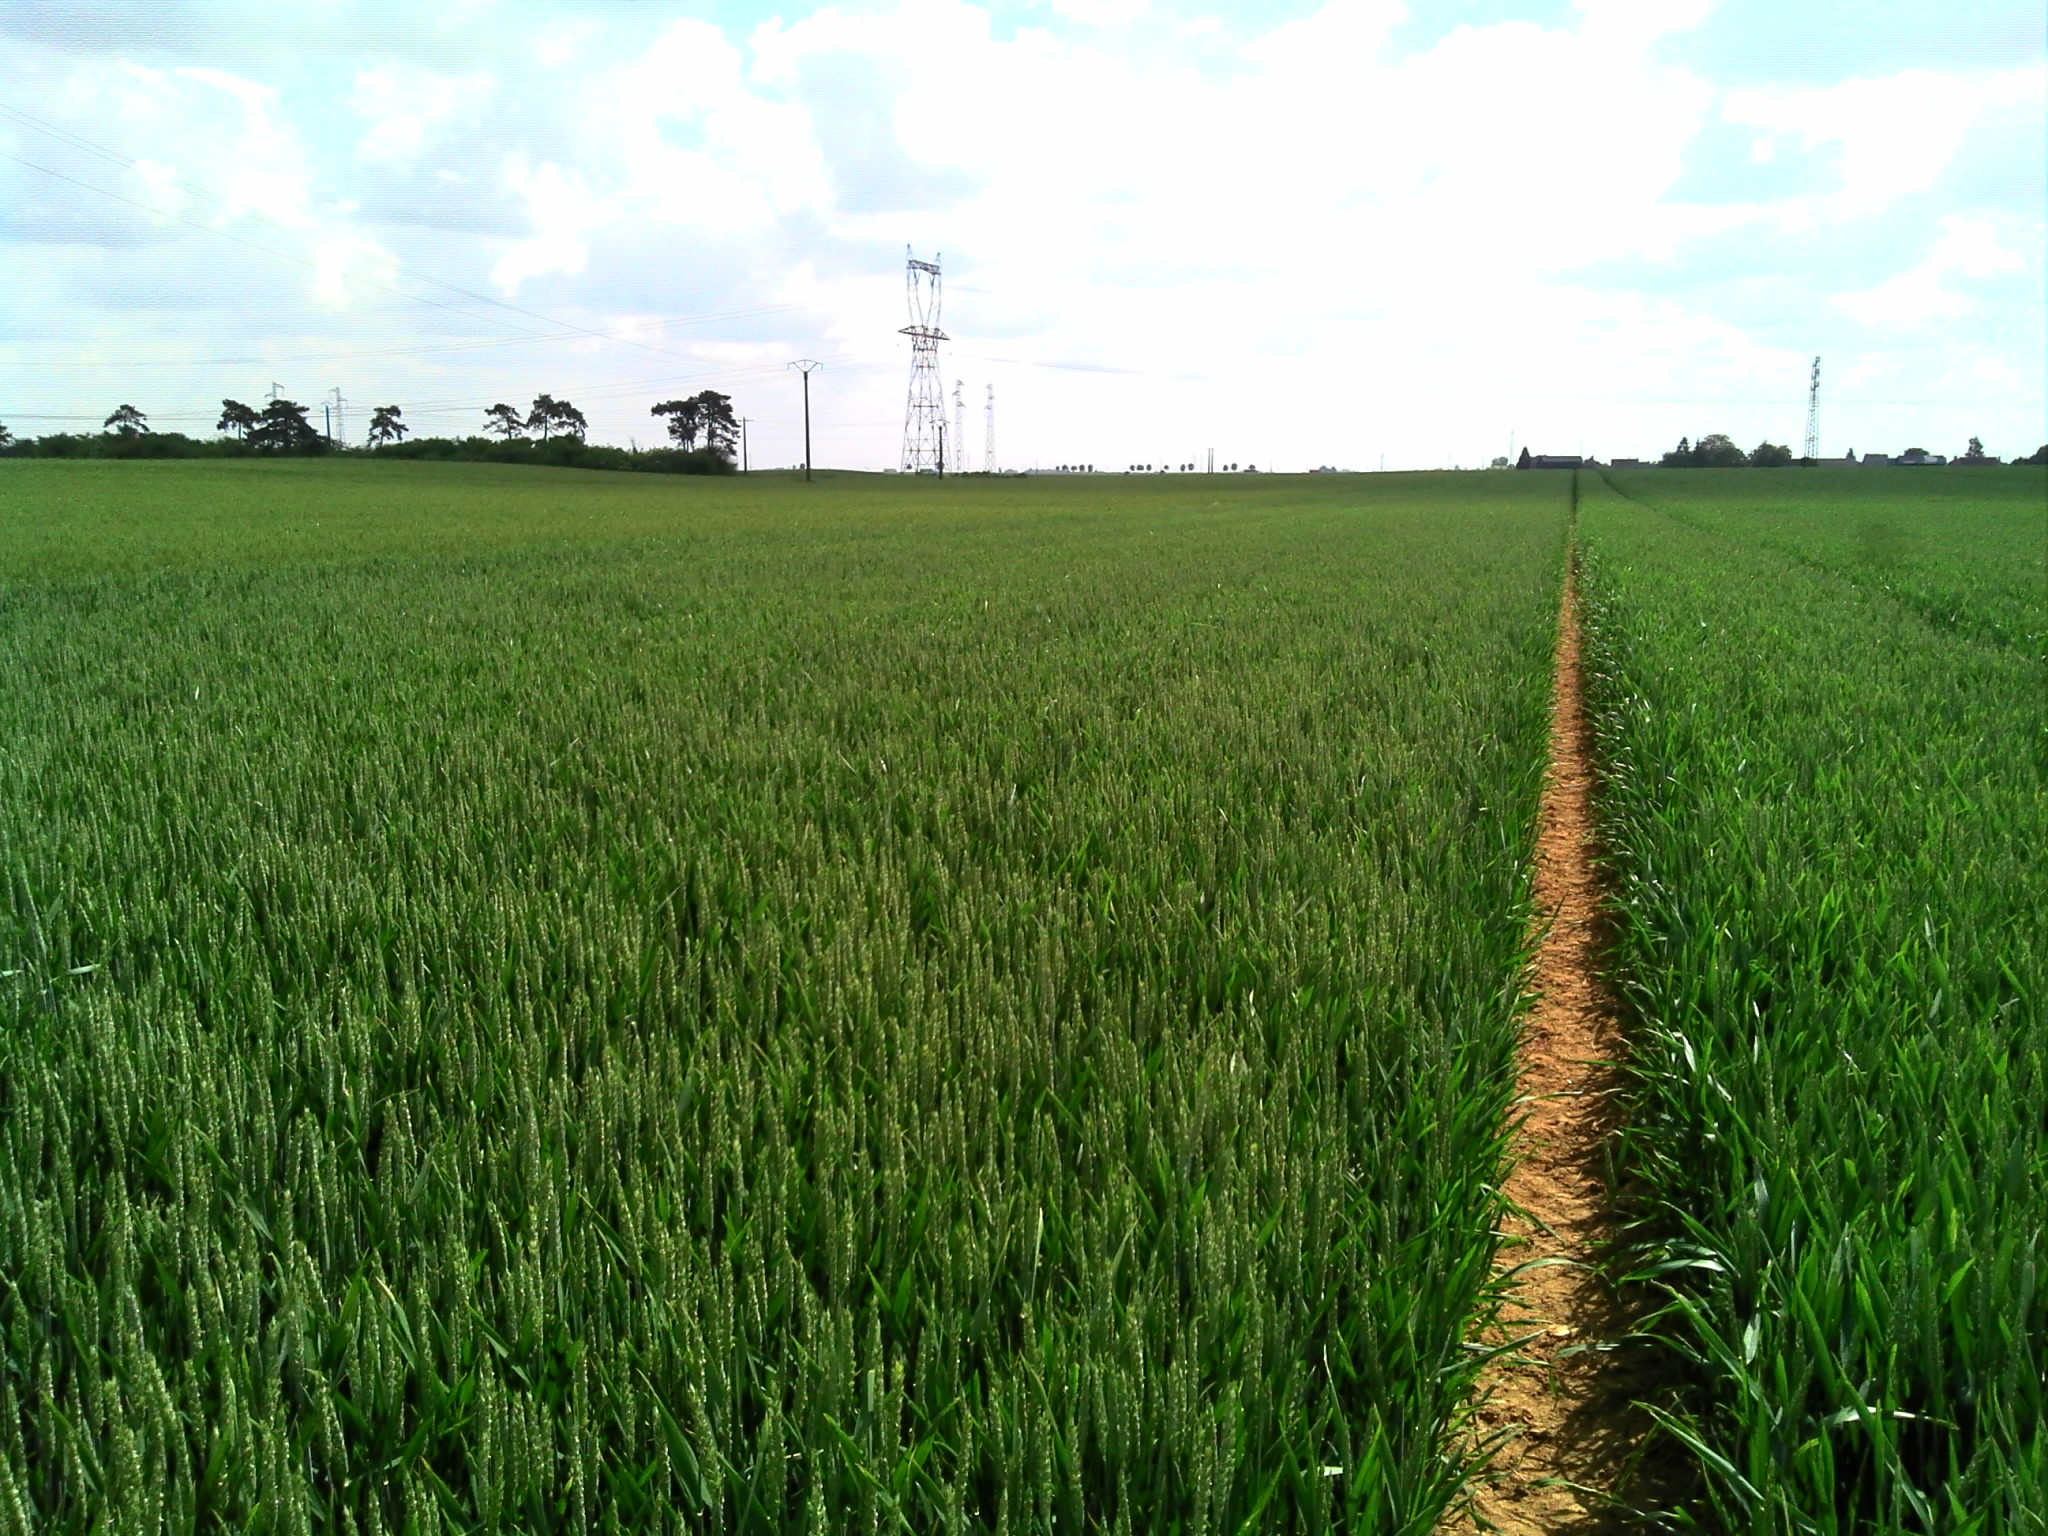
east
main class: Cropland
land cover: Common wheat
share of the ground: > 75 %
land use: Agriculture (excluding fallow land and kitchen gardens)
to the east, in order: Common wheat
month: May
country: FR
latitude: 48.2342
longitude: 1.9220
